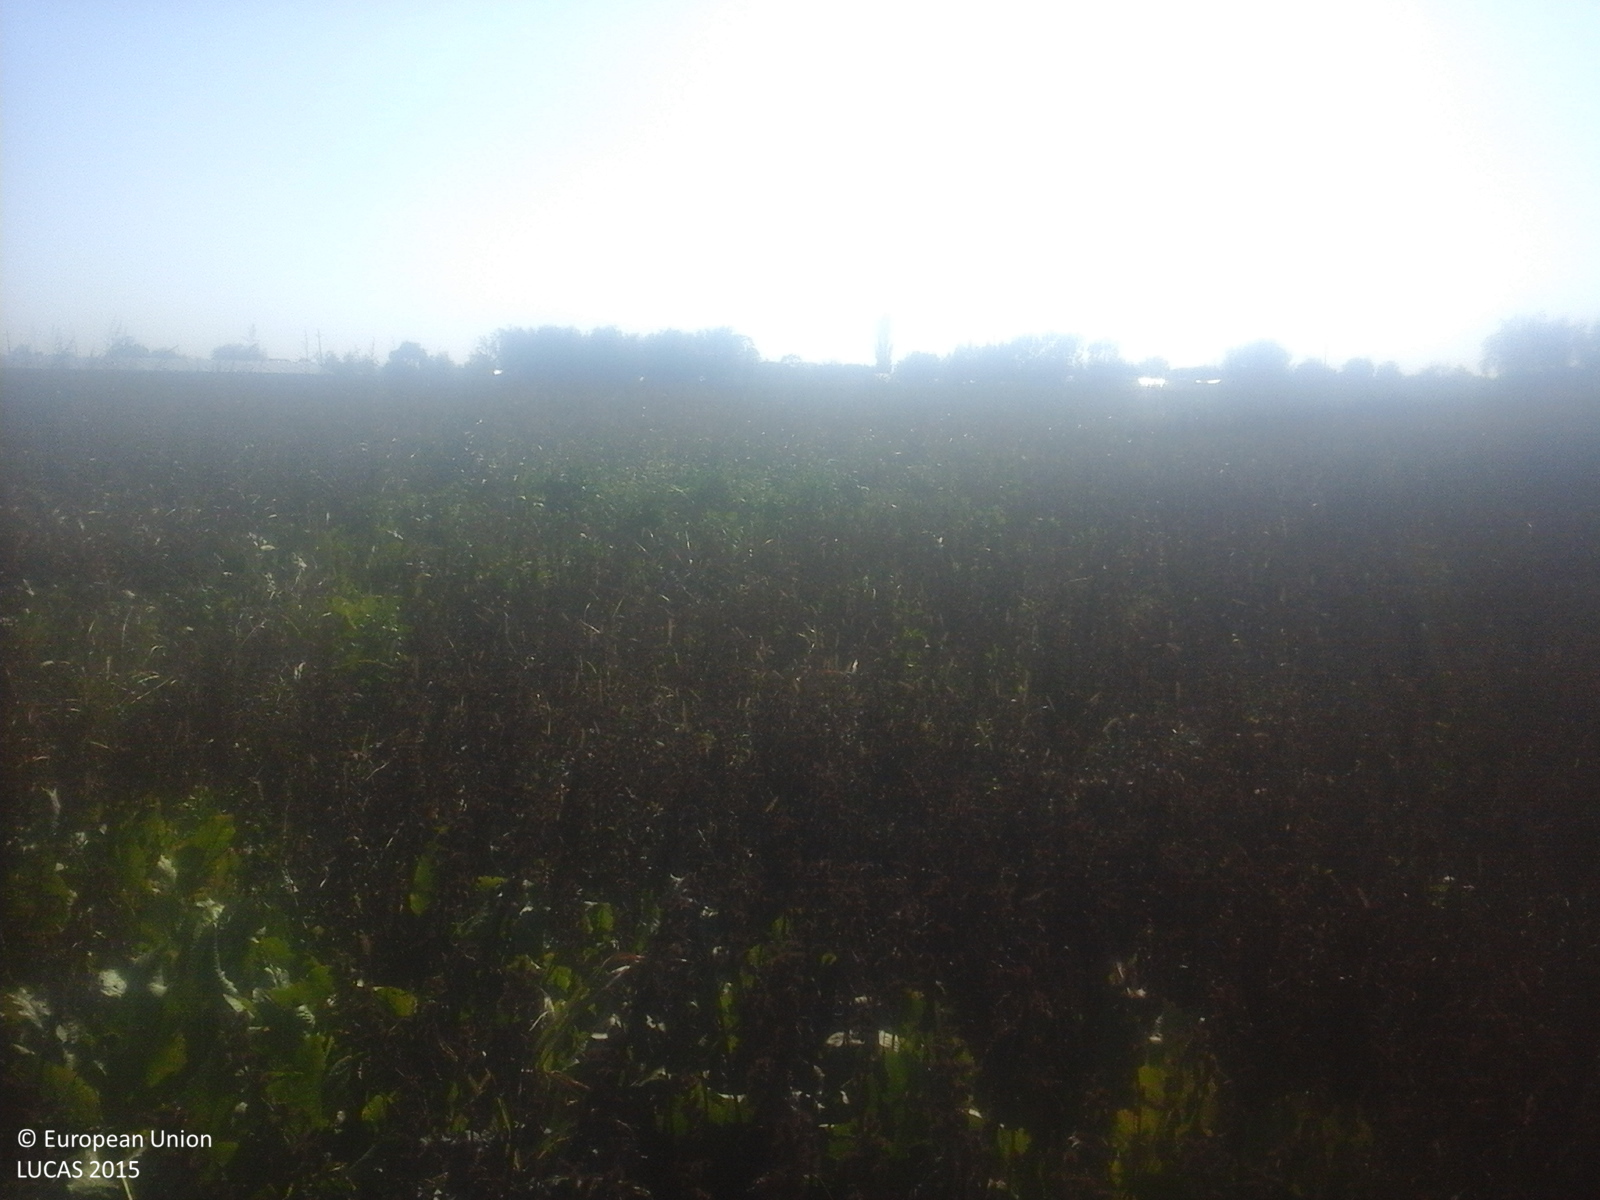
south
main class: Grassland
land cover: Spontaneously vegetated surfaces
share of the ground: > 75 %
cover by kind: herbaceous plants 100 %
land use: Fallow land
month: October
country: RO
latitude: 45.8311
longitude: 27.1787
